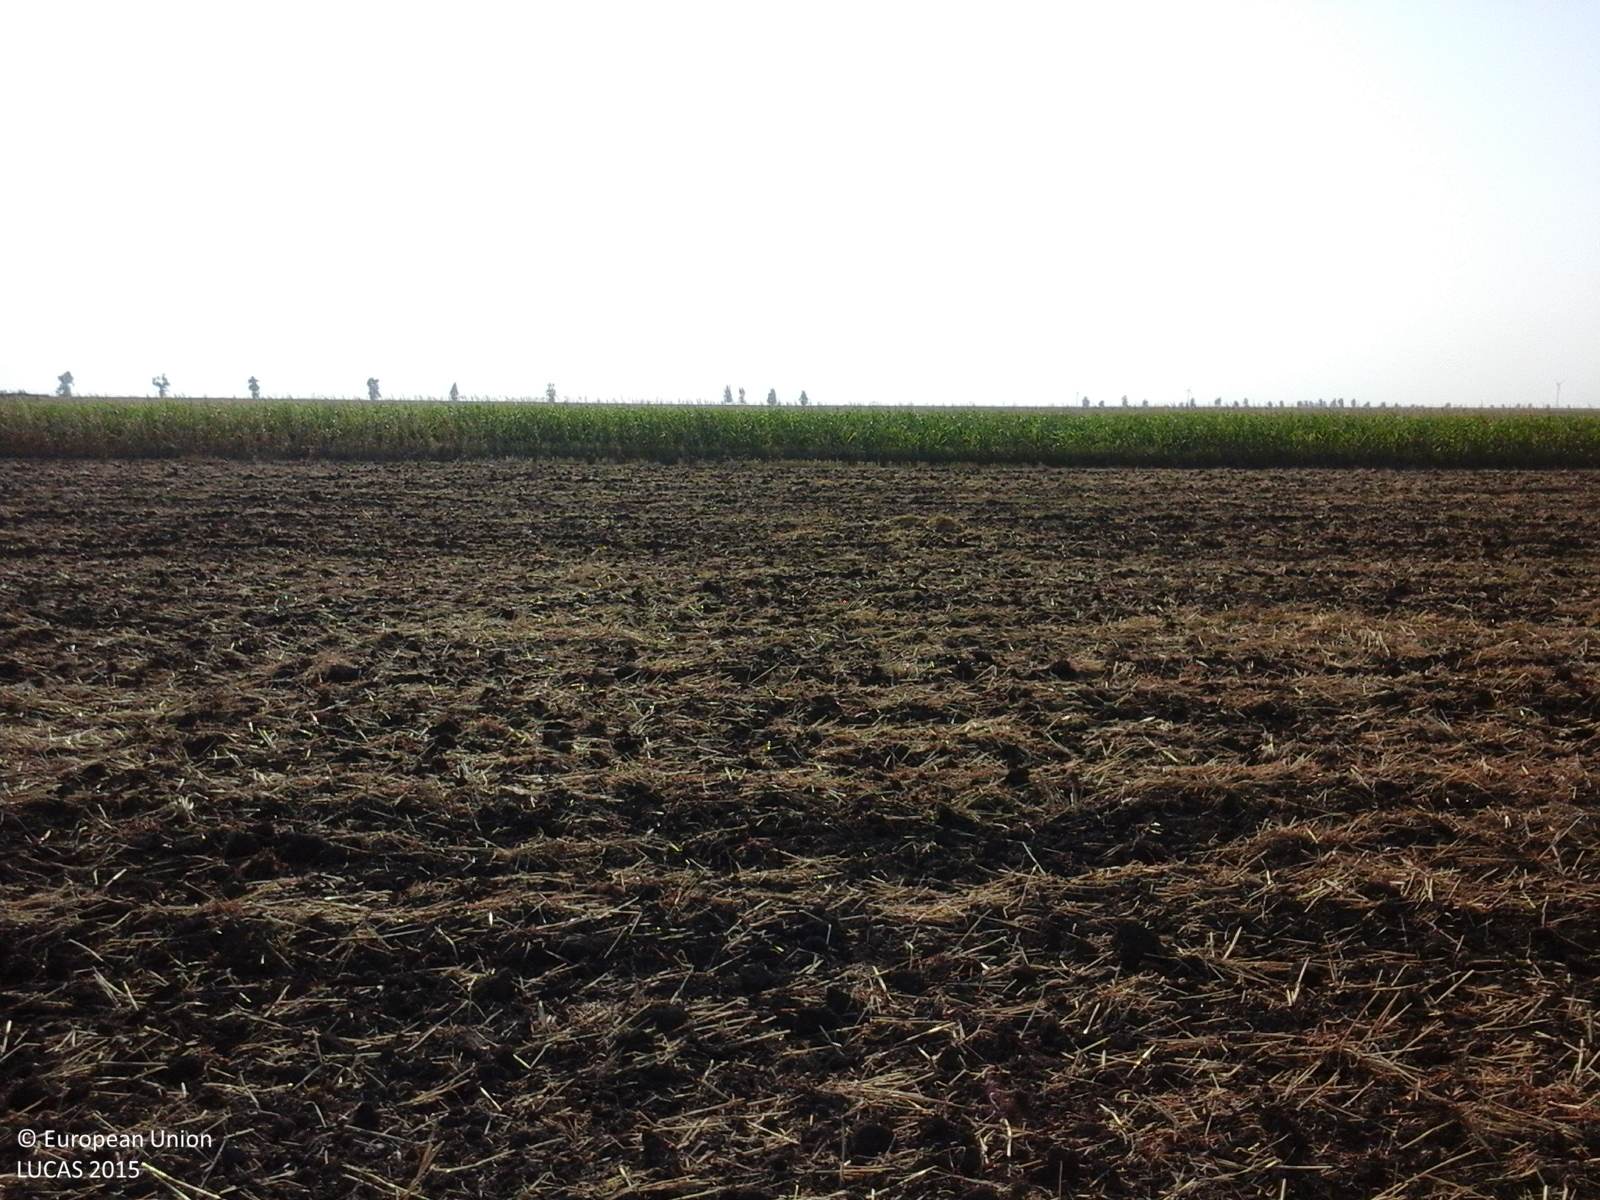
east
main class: Cropland
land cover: Common wheat
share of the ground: 25 - 50 %
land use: Agriculture (excluding fallow land and kitchen gardens)
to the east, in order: Common wheat; Grass margins; Tracks; Grass margins; Maize
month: July
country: RO
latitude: 45.6870
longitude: 27.9265
